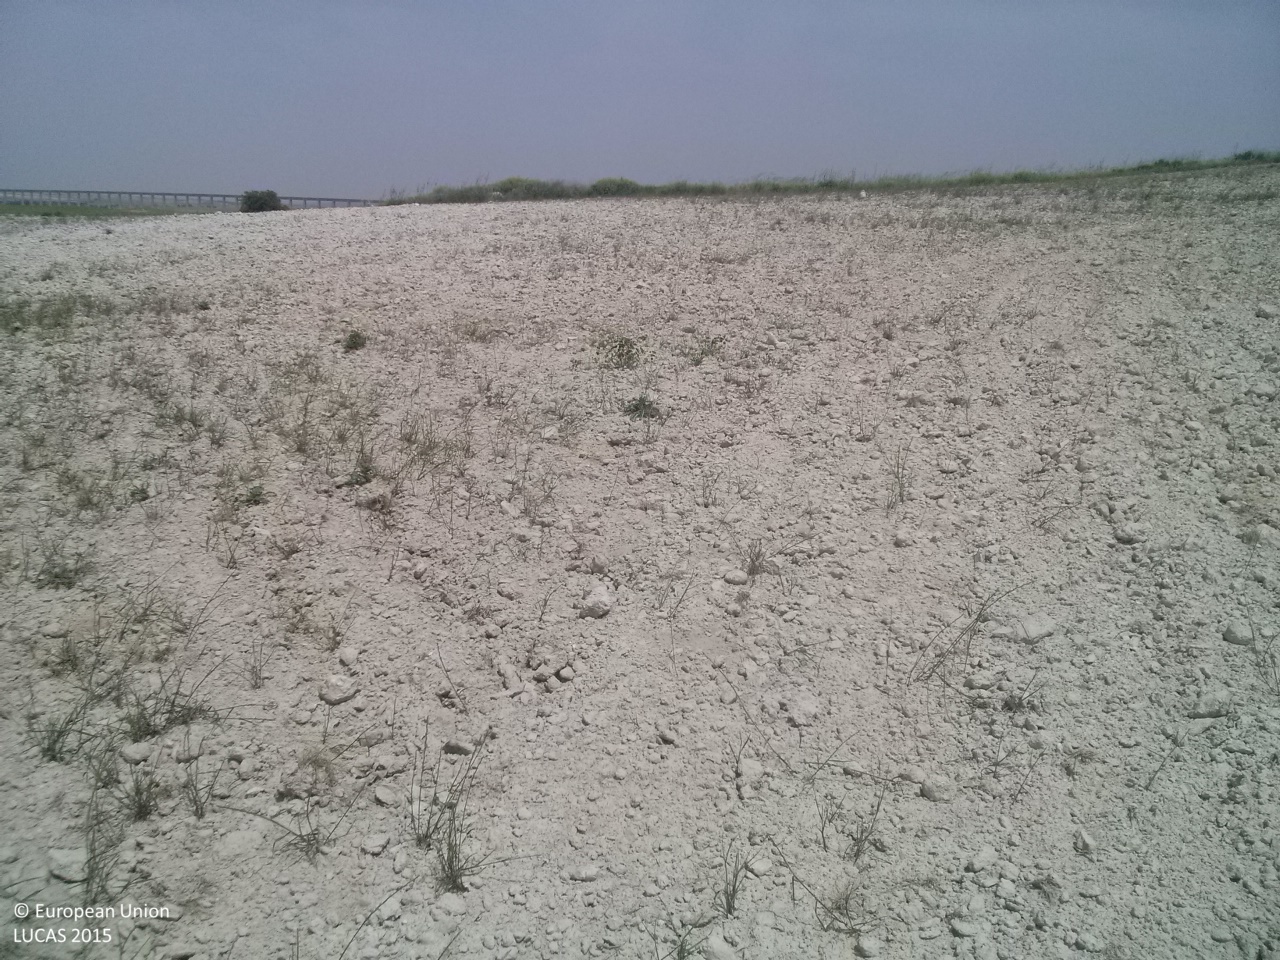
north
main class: Grassland
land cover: Spontaneously vegetated surfaces
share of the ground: < 10 %
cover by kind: unconsolidated bare surface 90 %, herbaceous plants 10 %
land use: Fallow land
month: May
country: ES
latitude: 39.9154
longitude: -2.6891
